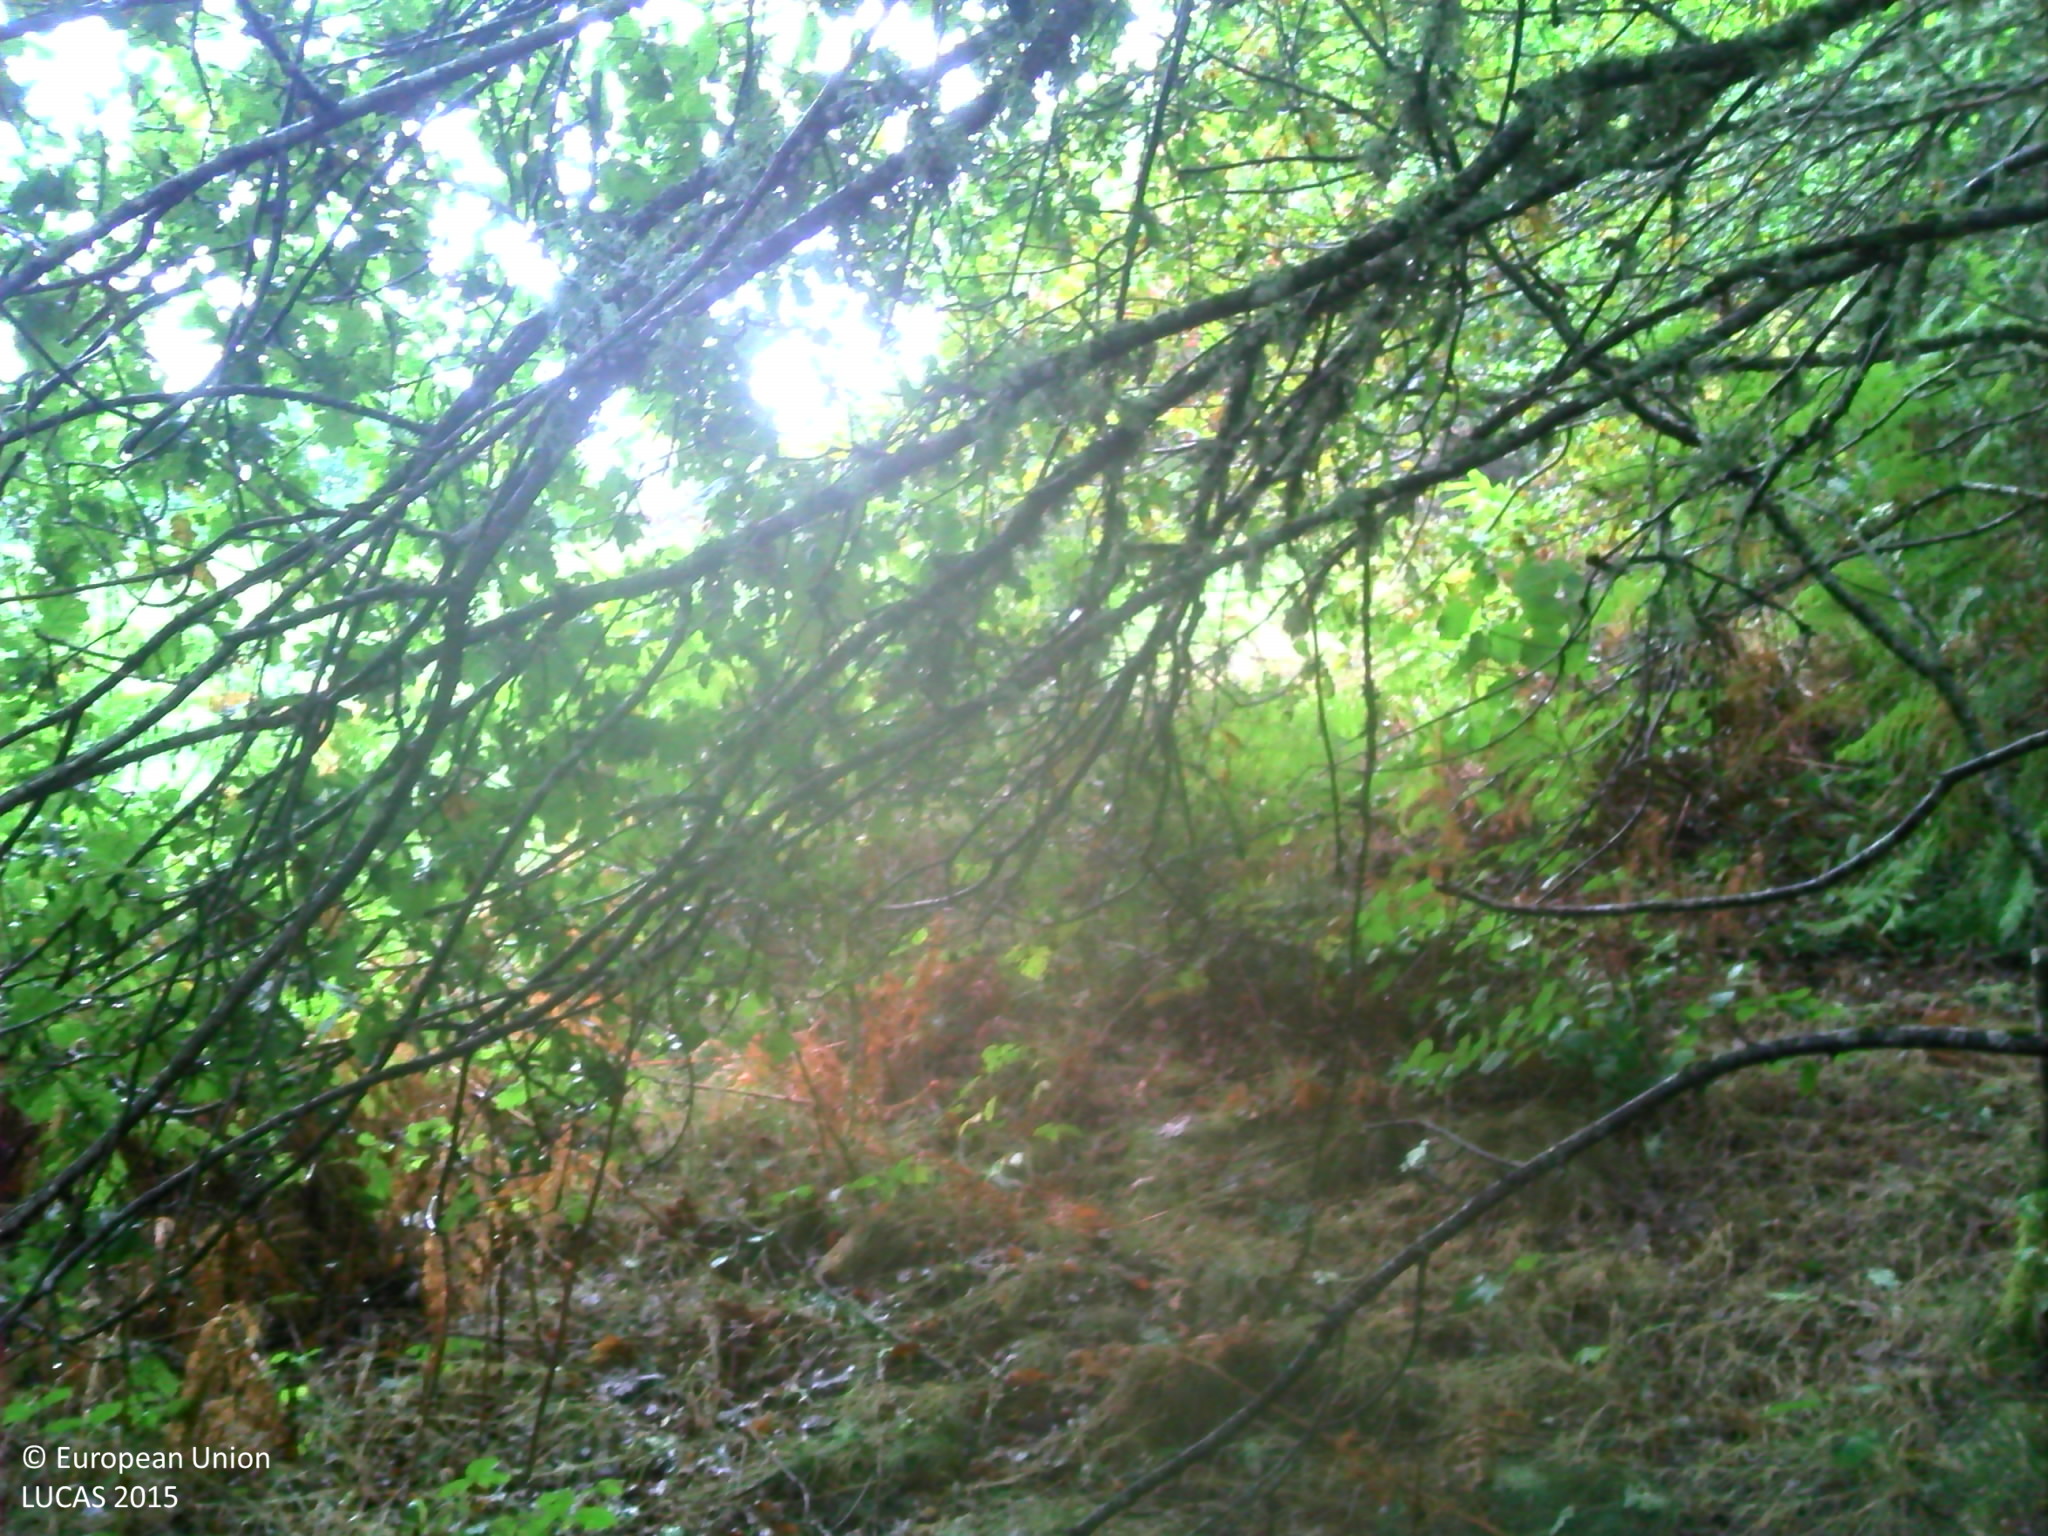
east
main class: Woodland
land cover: Broadleaved woodland
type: thermophilous deciduous forest
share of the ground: > 75 %
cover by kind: herbaceous plants 60 %, broadleaved forest trees 40 %
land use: Forestry
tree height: > 5 m
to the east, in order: Broadleaved woodland; Grassland without tree/shrub cover; Broadleaved woodland; Tracks; Broadleaved woodland; Tracks; Broadleaved woodland; Spontaneously vegetated surfaces; Grassland without tree/shrub cover
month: August
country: FR
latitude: 45.5301
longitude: 1.8132
